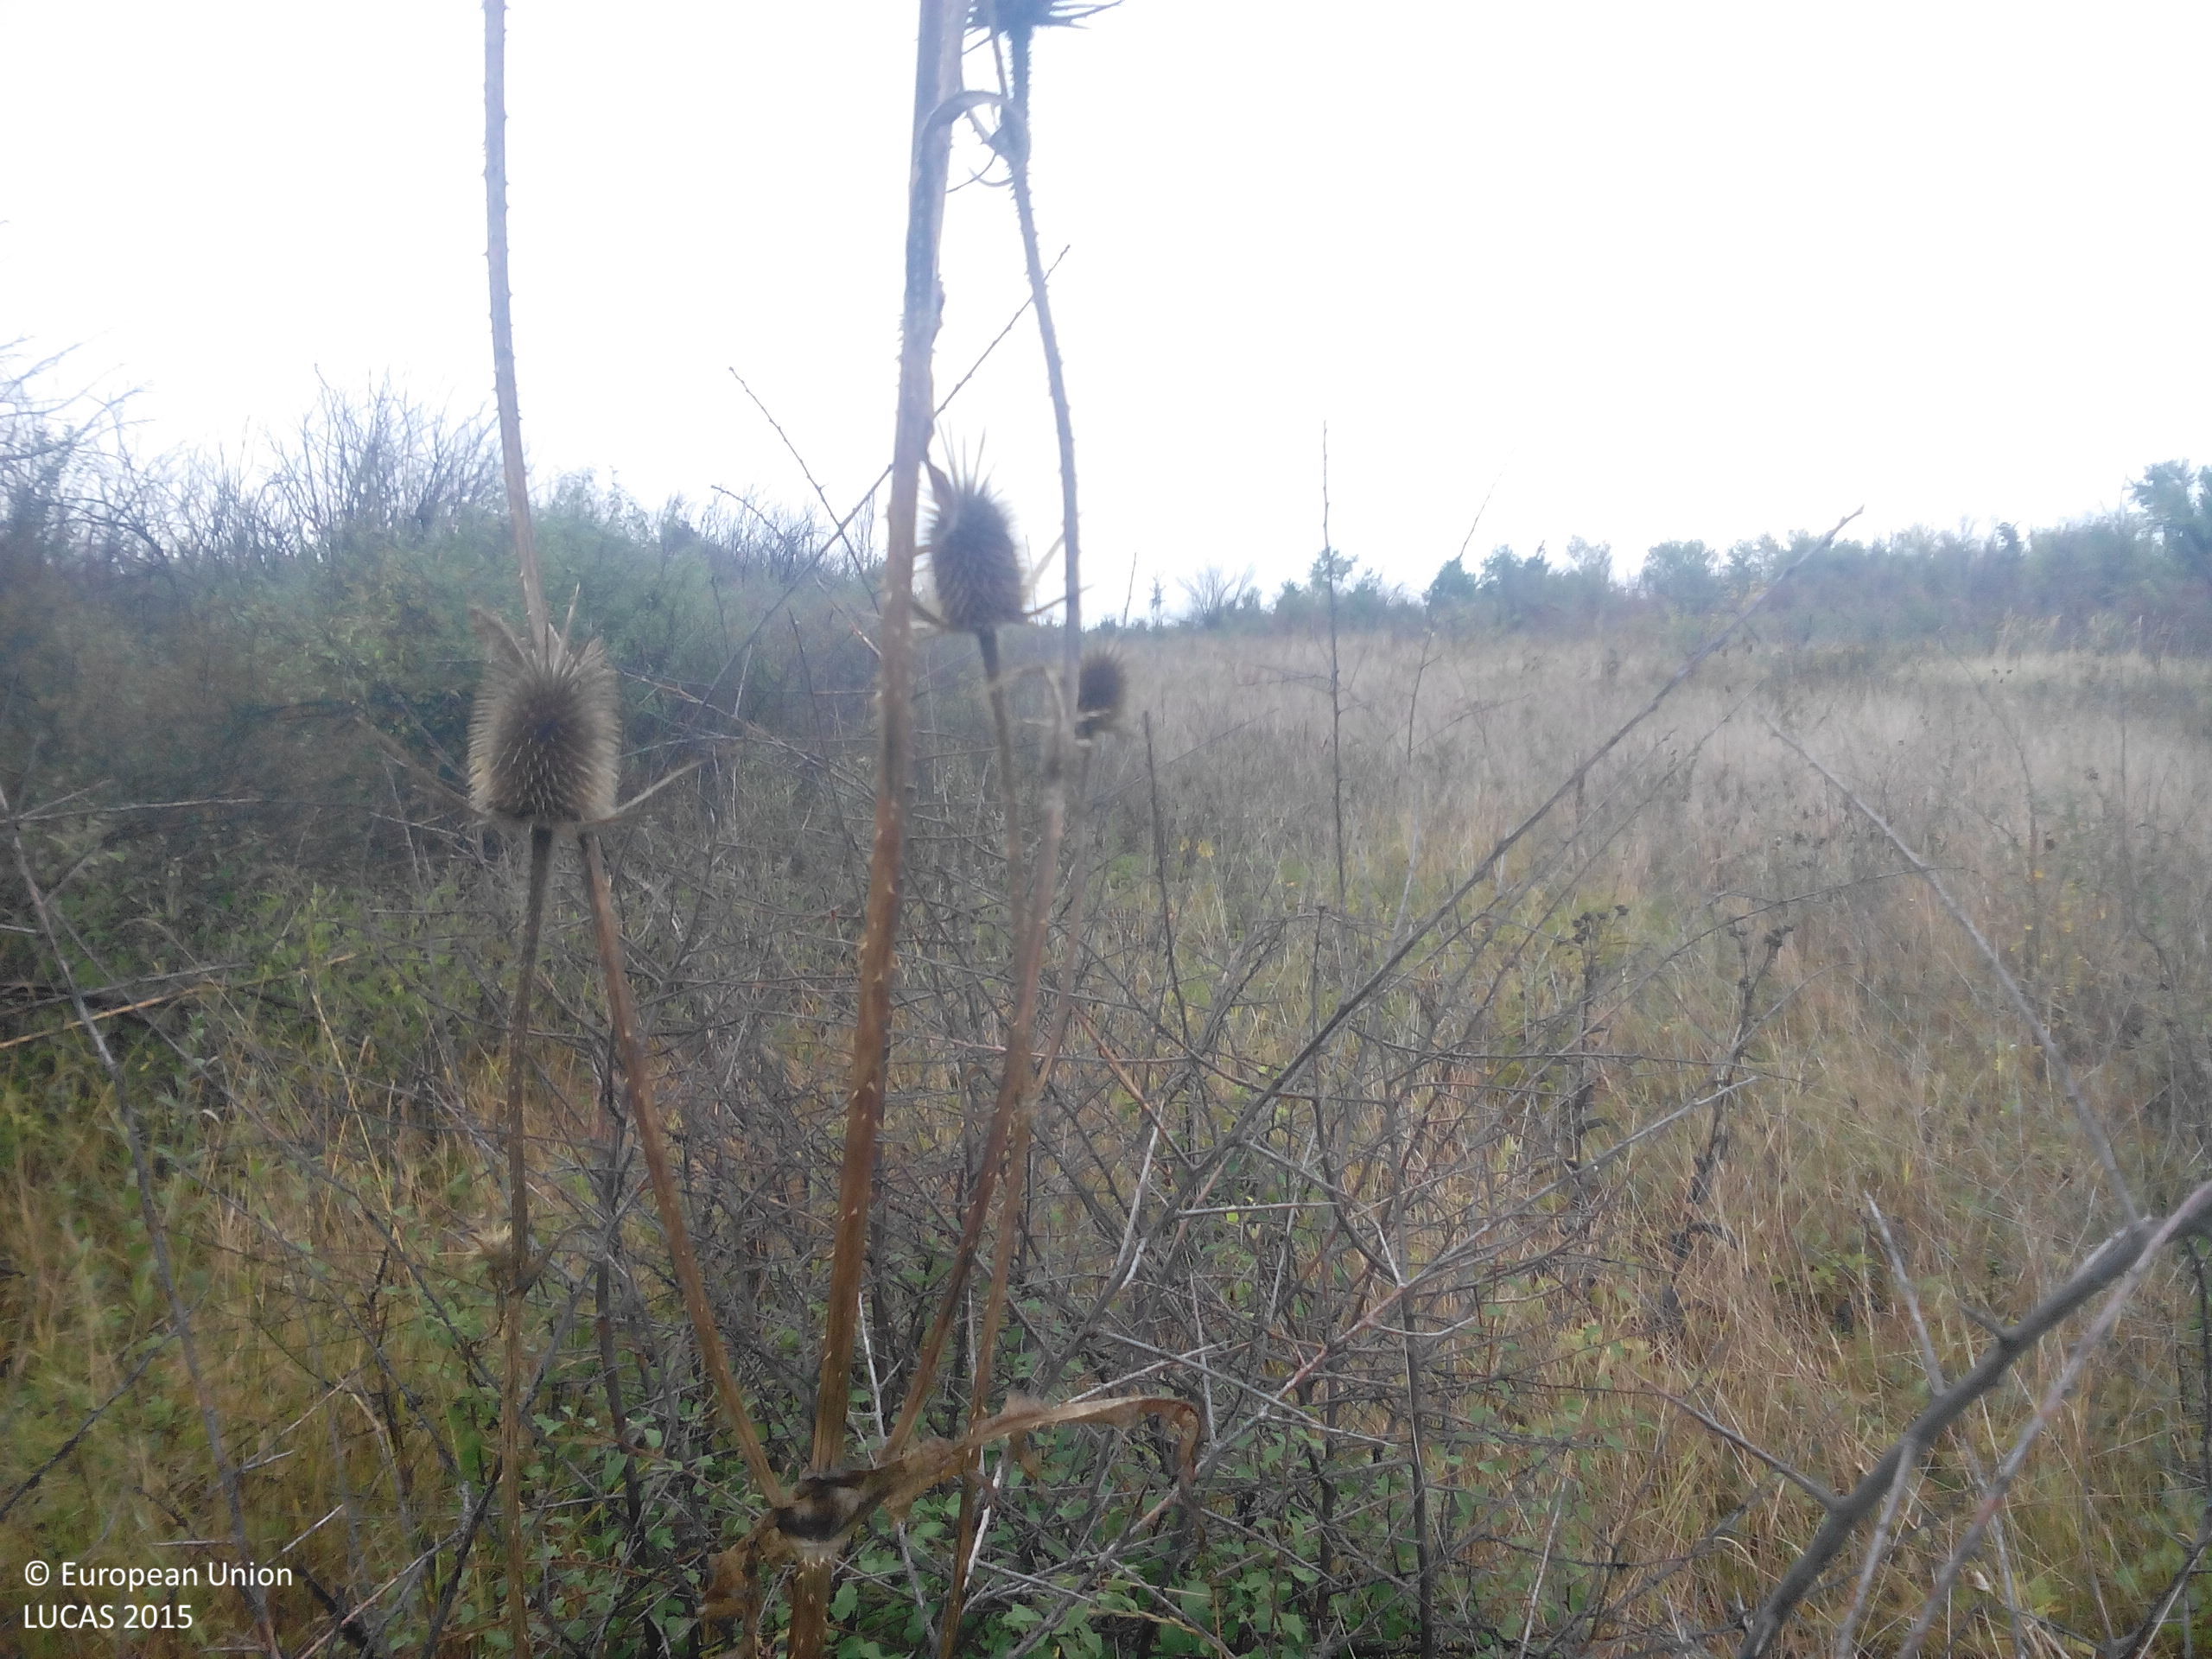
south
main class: Shrubland
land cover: Shrubland with sparse tree cover
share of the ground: > 75 %
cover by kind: shrubs 80 %, herbaceous plants 15 %, broadleaved forest trees 5 %
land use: Abandoned areas
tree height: > 5 m
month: October
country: BG
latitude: 43.1867
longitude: 24.1903
